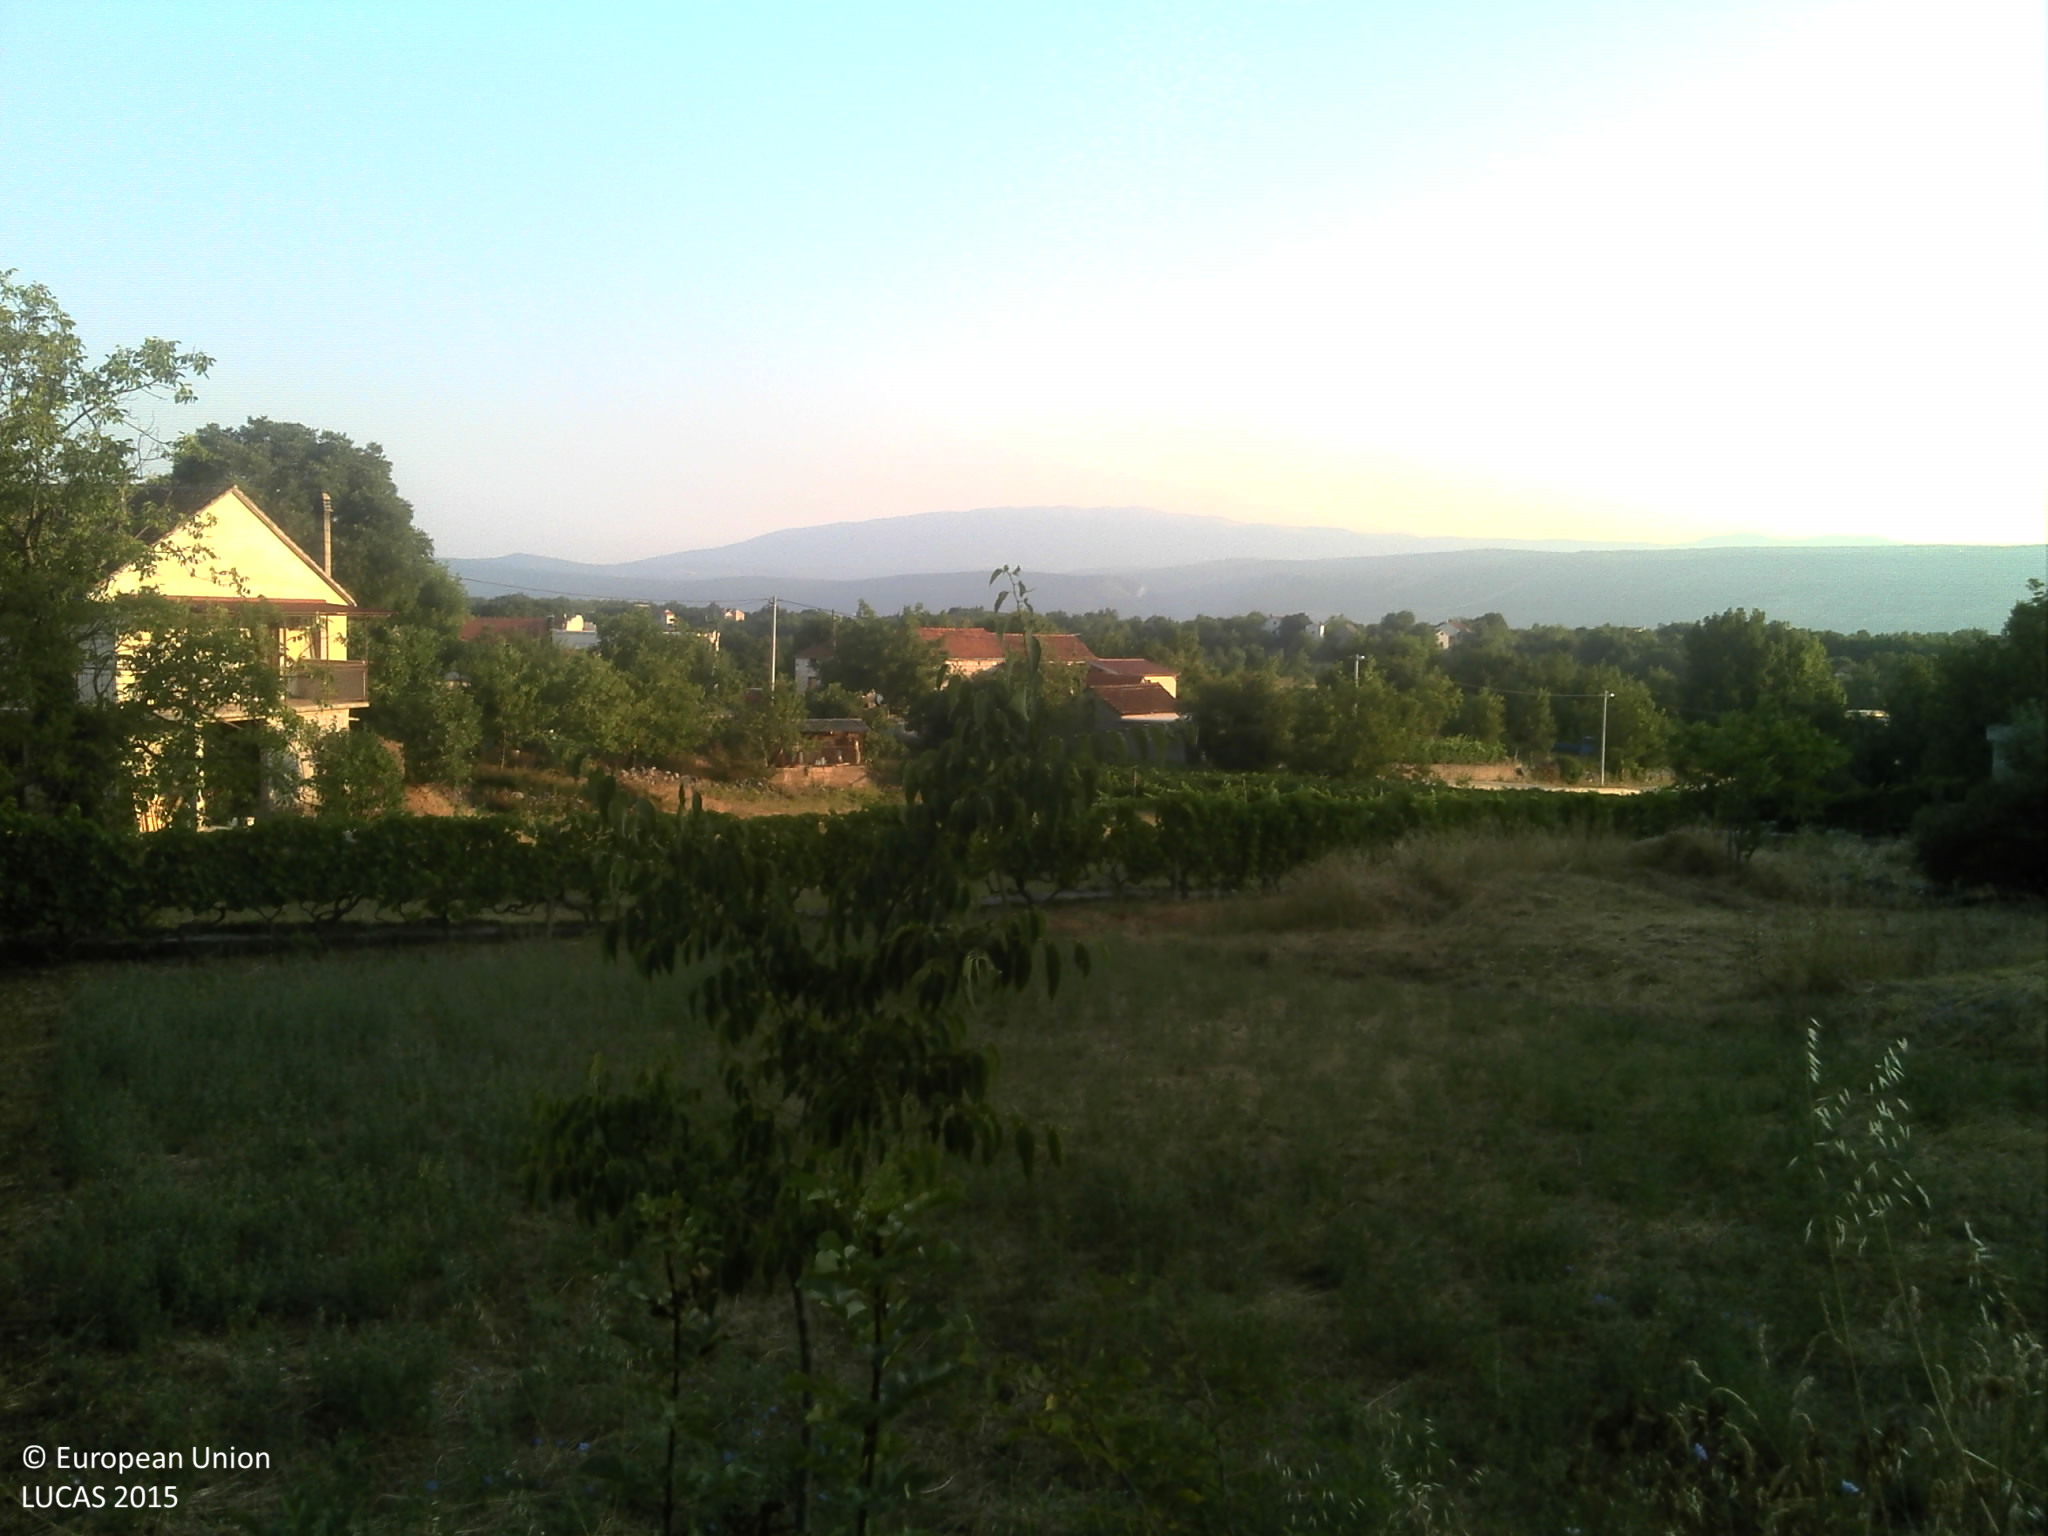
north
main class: Grassland
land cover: Grassland without tree/shrub cover
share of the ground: > 75 %
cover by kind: herbaceous plants 95 %, shrubs 5 %
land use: Agriculture (excluding fallow land and kitchen gardens)
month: July
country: HR
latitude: 43.4145
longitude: 17.1671
